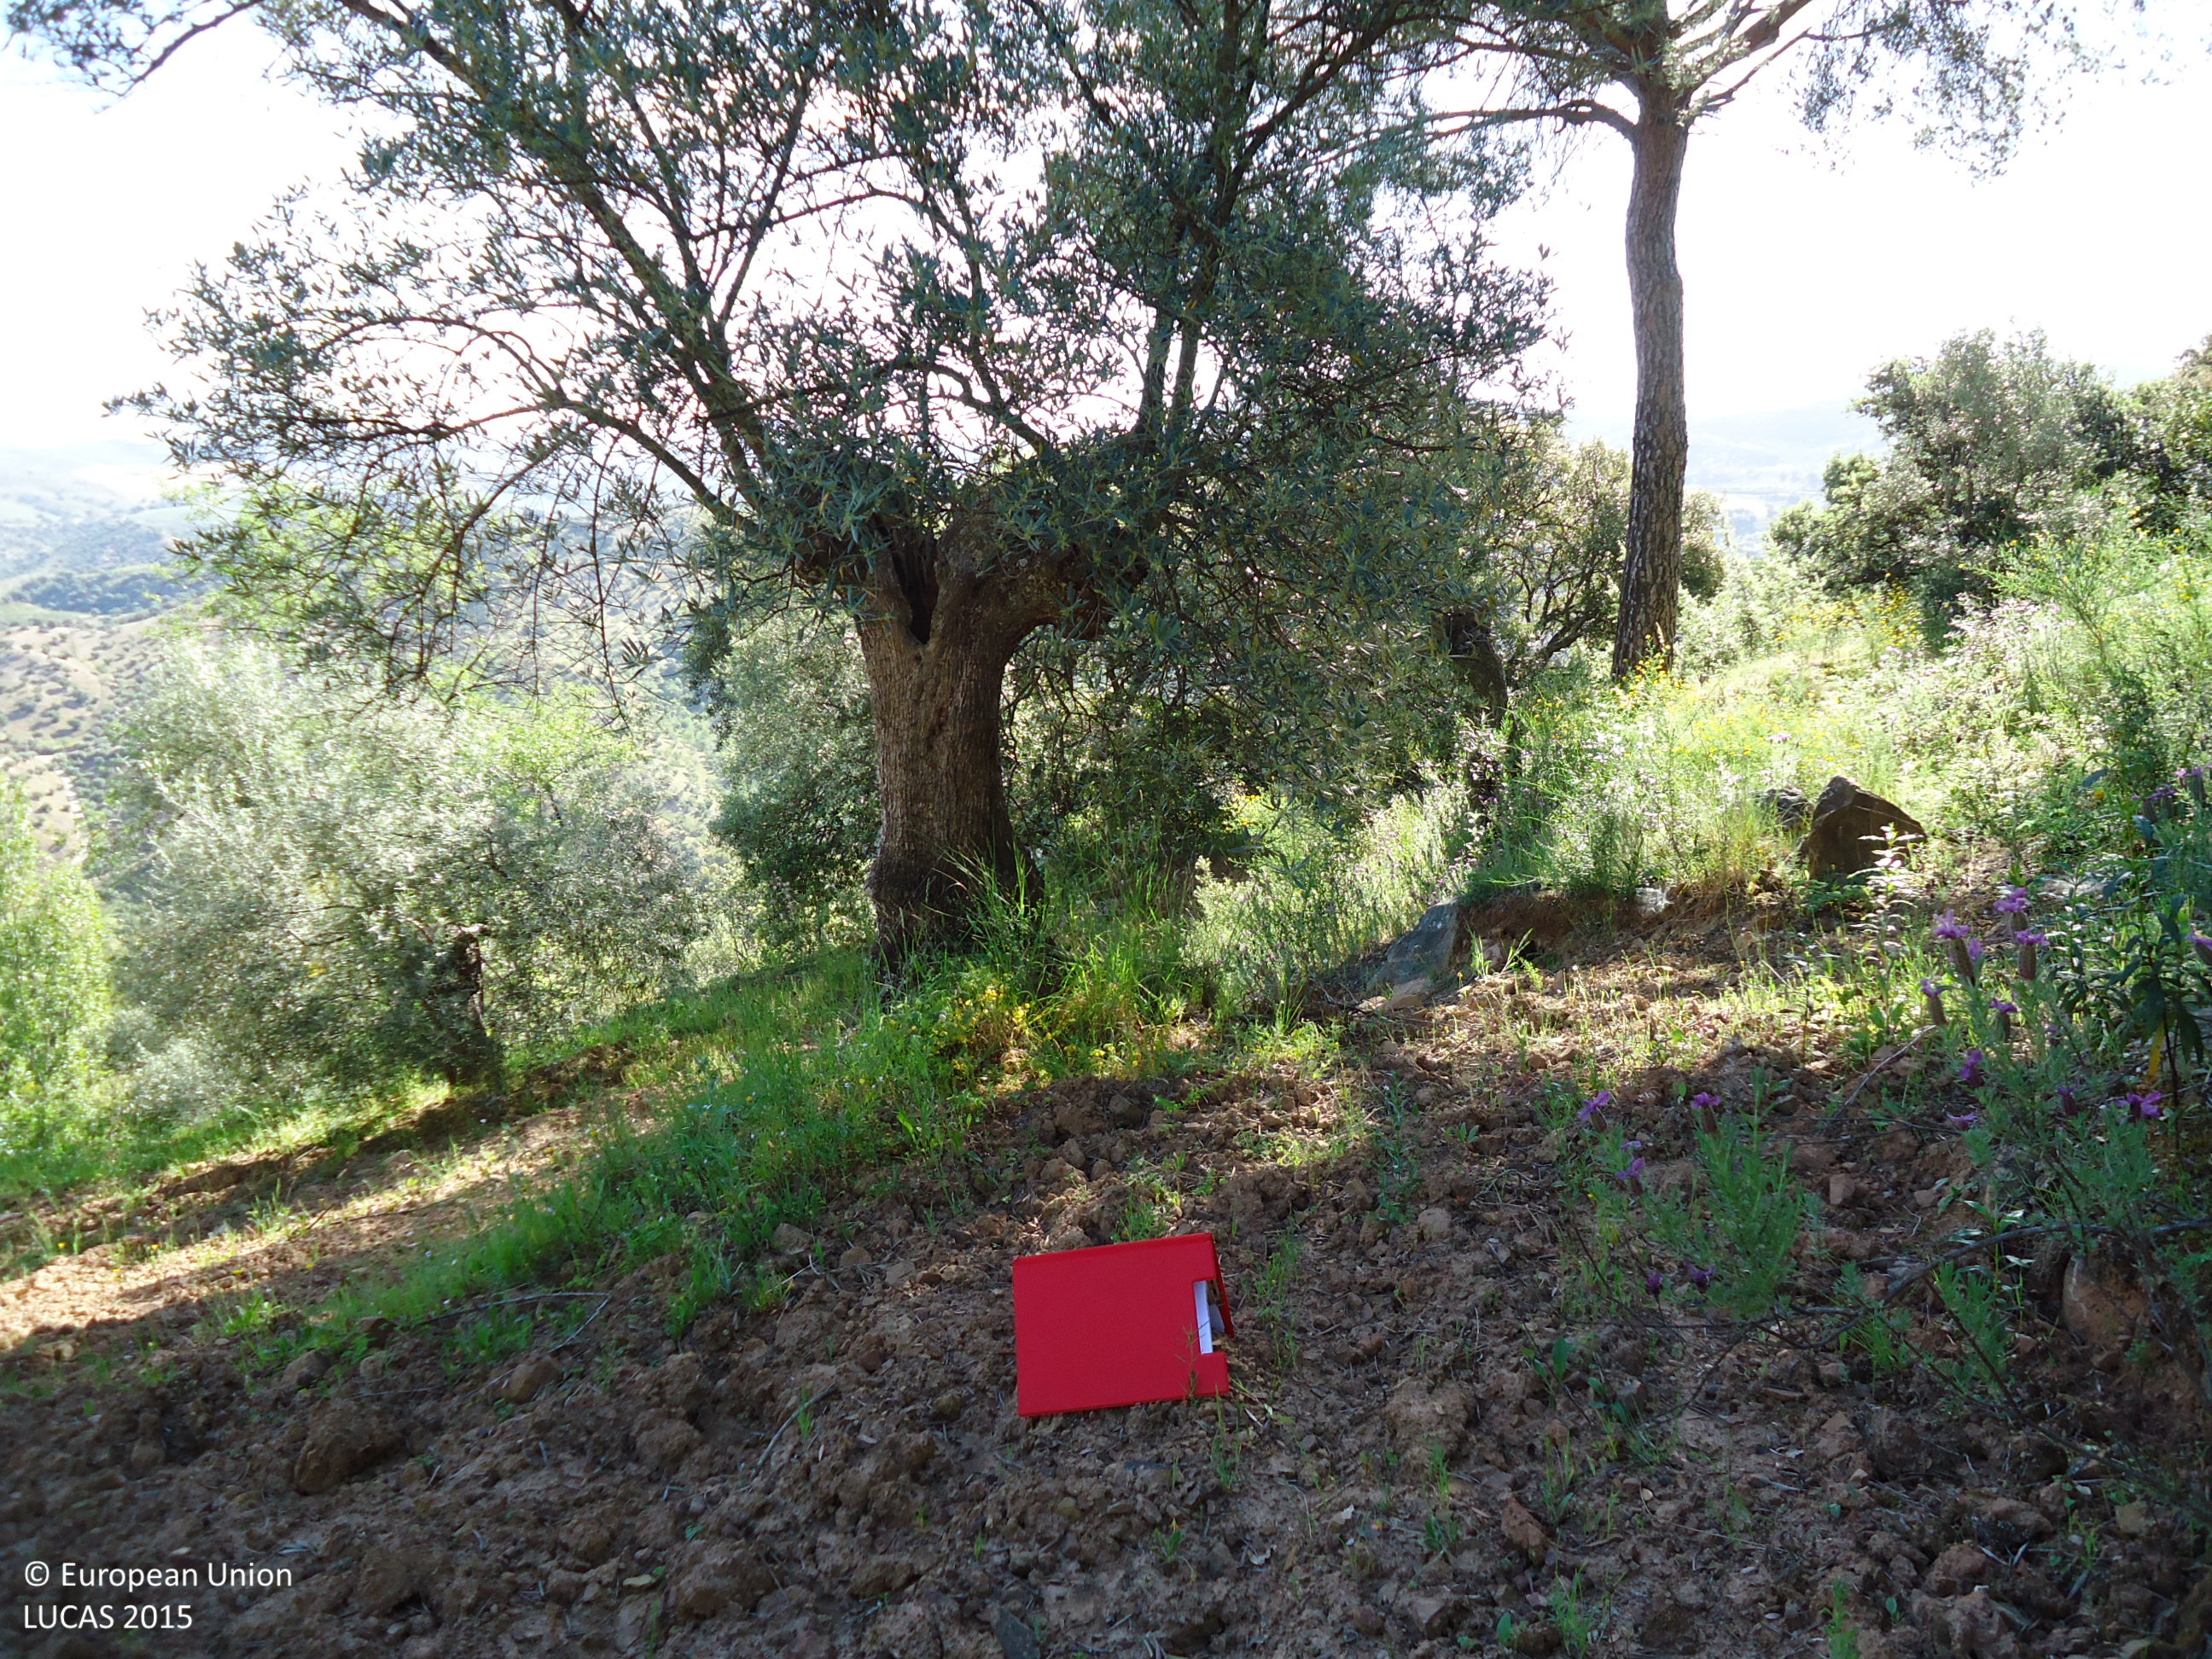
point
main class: Cropland
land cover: Olive groves
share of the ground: 50 - 75 %
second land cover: Other bare soil
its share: > 75 %
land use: Agriculture (excluding fallow land and kitchen gardens)
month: May
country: ES
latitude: 36.8637
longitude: -5.3375
